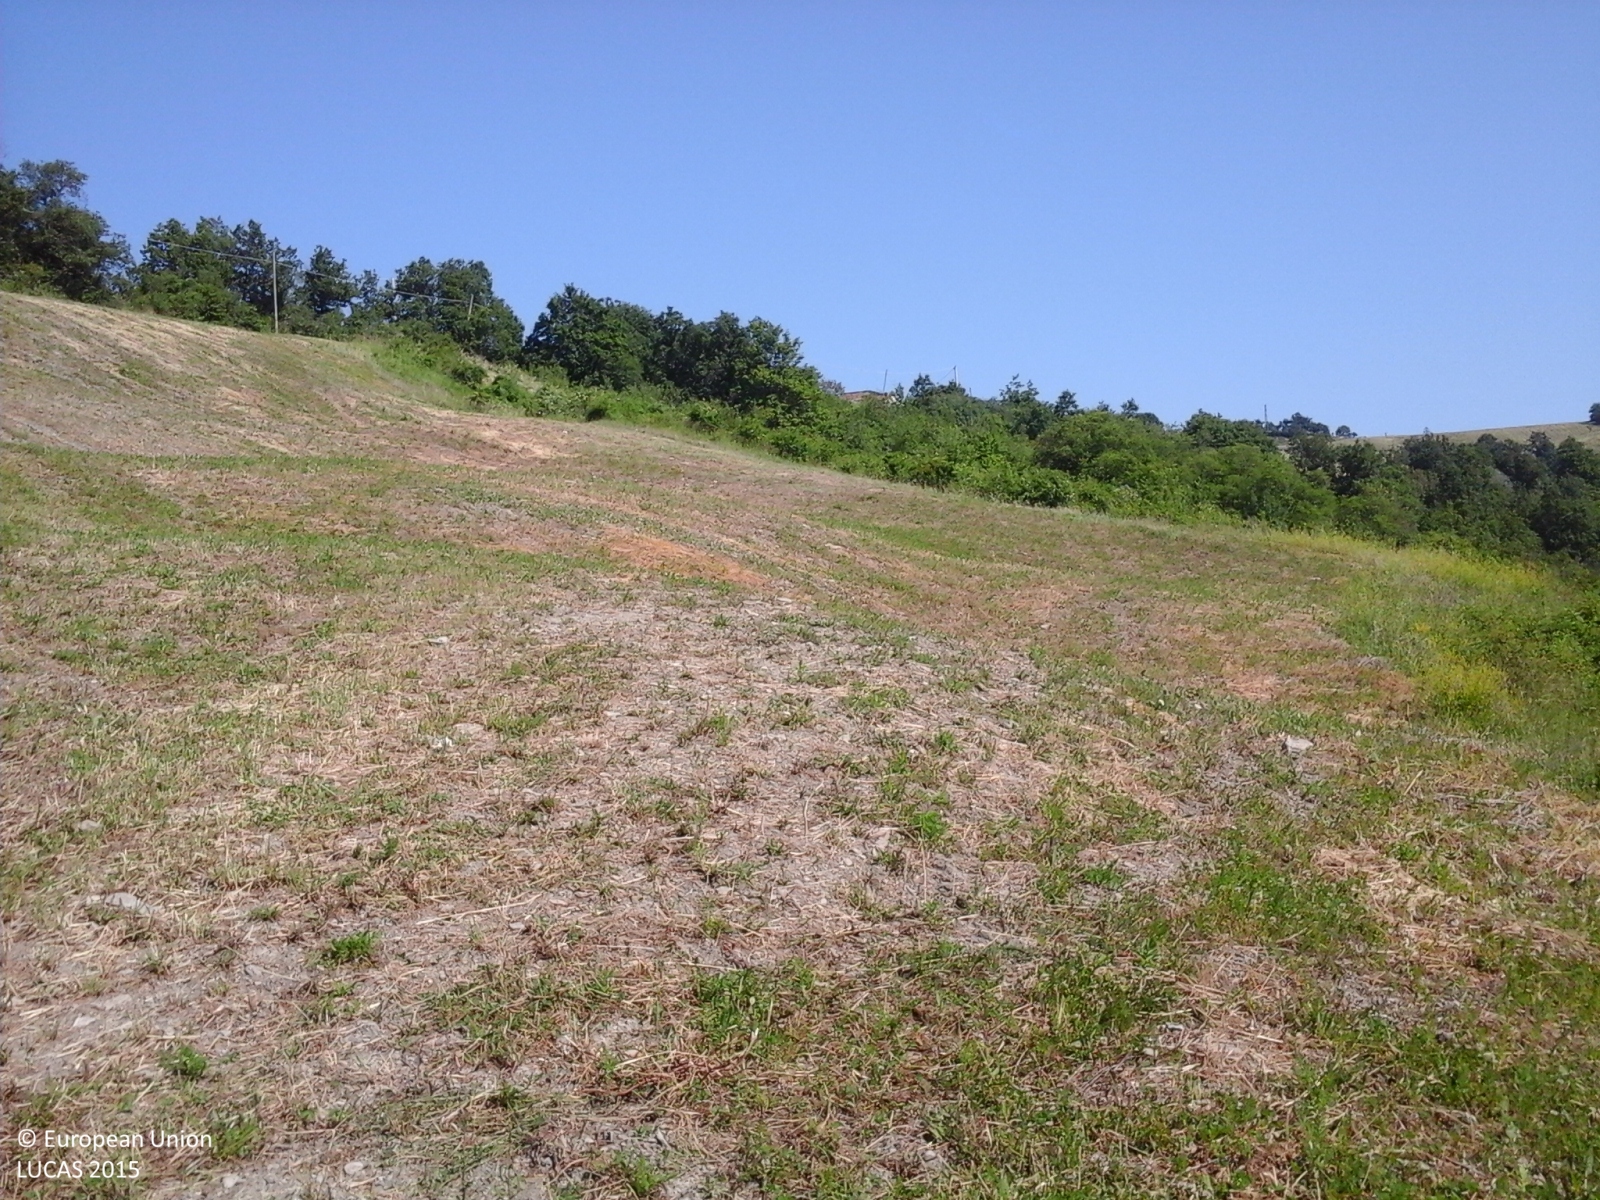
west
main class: Woodland
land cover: Broadleaved woodland
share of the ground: > 75 %
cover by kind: broadleaved forest trees 100 %
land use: Semi-natural and natural areas not in use
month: June
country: IT
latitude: 44.7112
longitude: 9.8866
